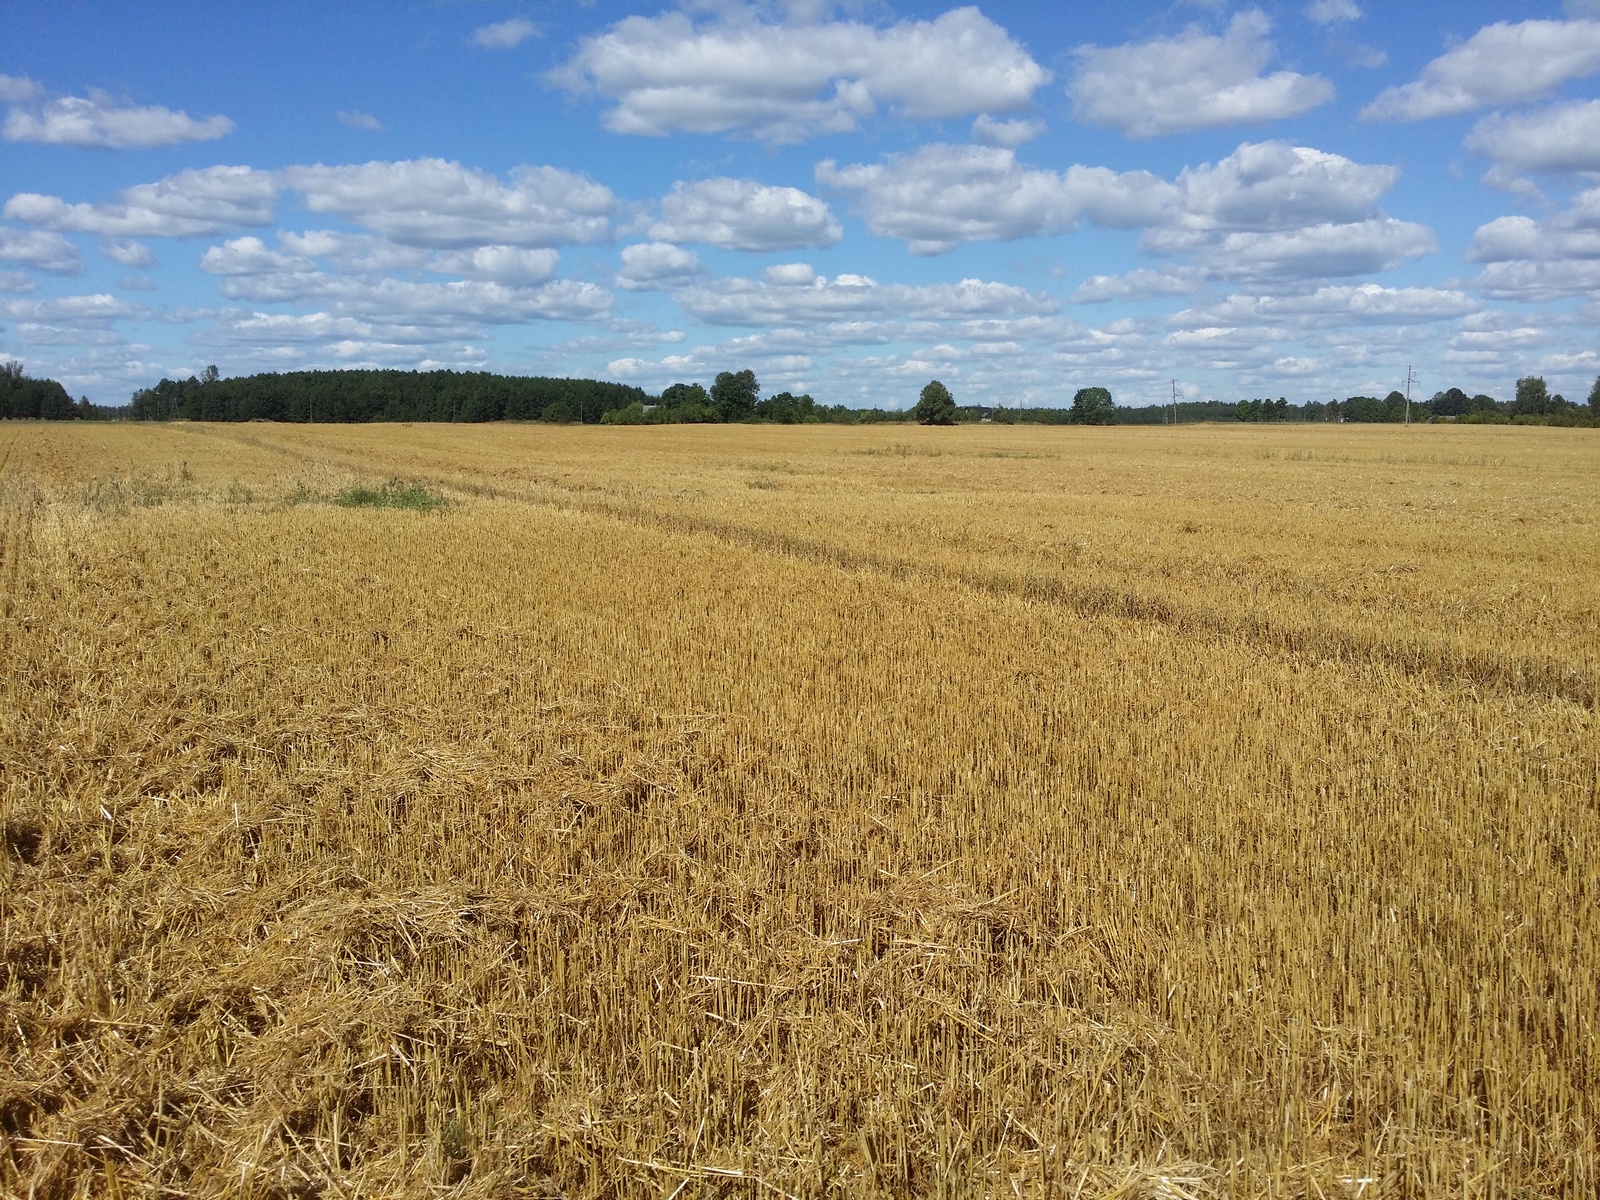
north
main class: Cropland
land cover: Common wheat
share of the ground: 50 - 75 %
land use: Agriculture (excluding fallow land and kitchen gardens)
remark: Harvested field
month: August
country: LV
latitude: 57.0168
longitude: 27.6567
